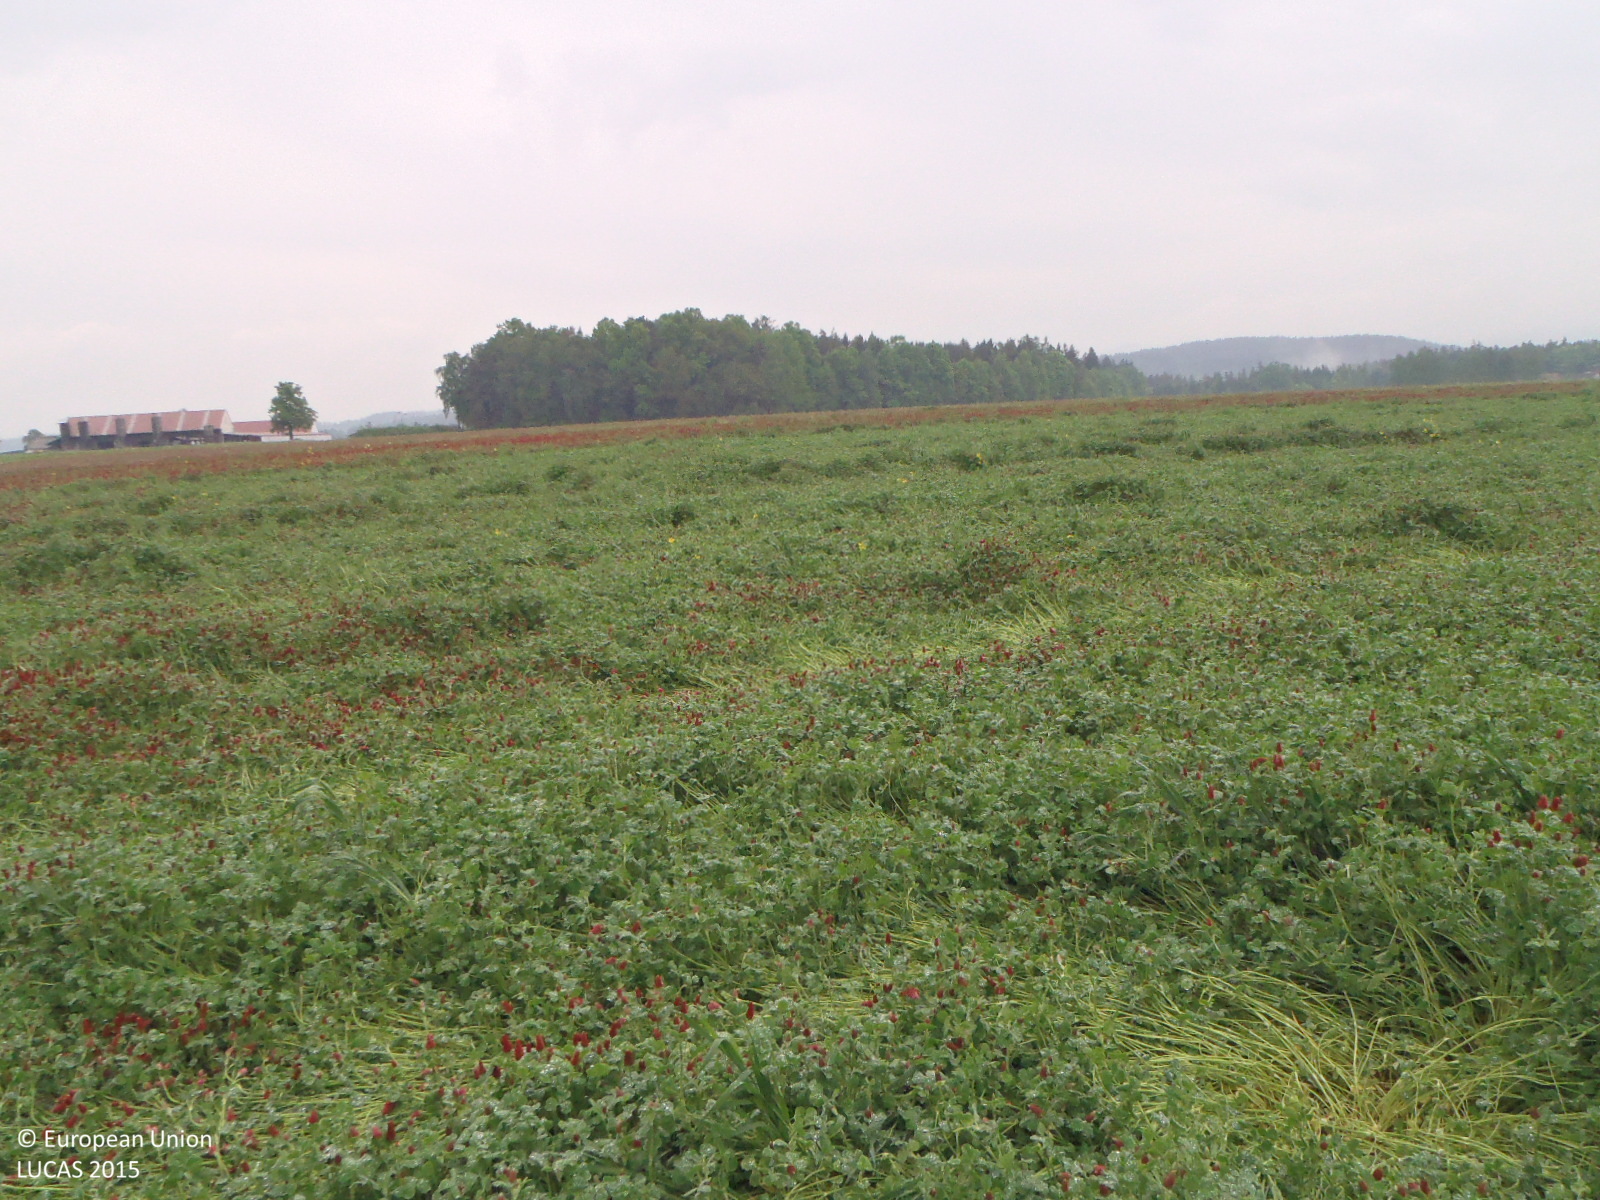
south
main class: Cropland
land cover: Clovers
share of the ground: > 75 %
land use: Agriculture (excluding fallow land and kitchen gardens)
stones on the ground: < 10 %
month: May
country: CZ
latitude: 48.8183
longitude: 14.4544
